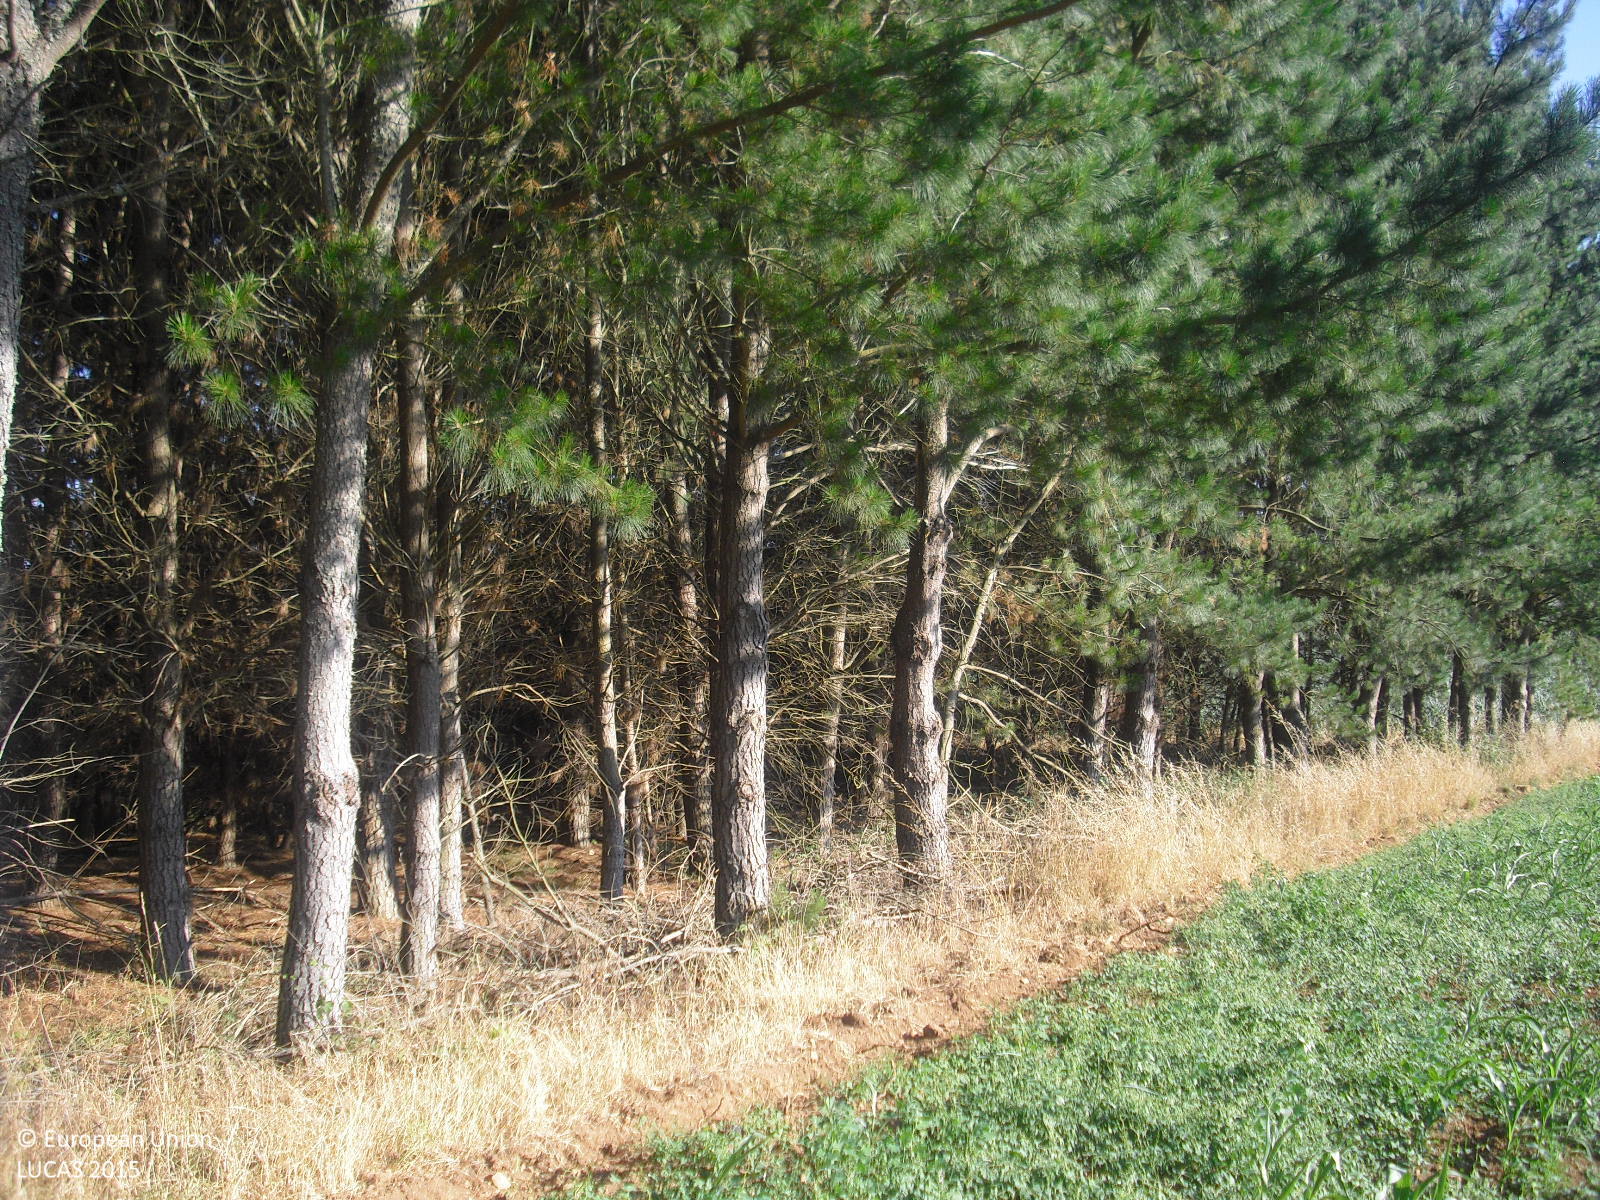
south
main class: Cropland
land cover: Maize
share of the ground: > 75 %
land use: Agriculture (excluding fallow land and kitchen gardens)
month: July
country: ES
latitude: 42.5855
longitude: -7.5324
